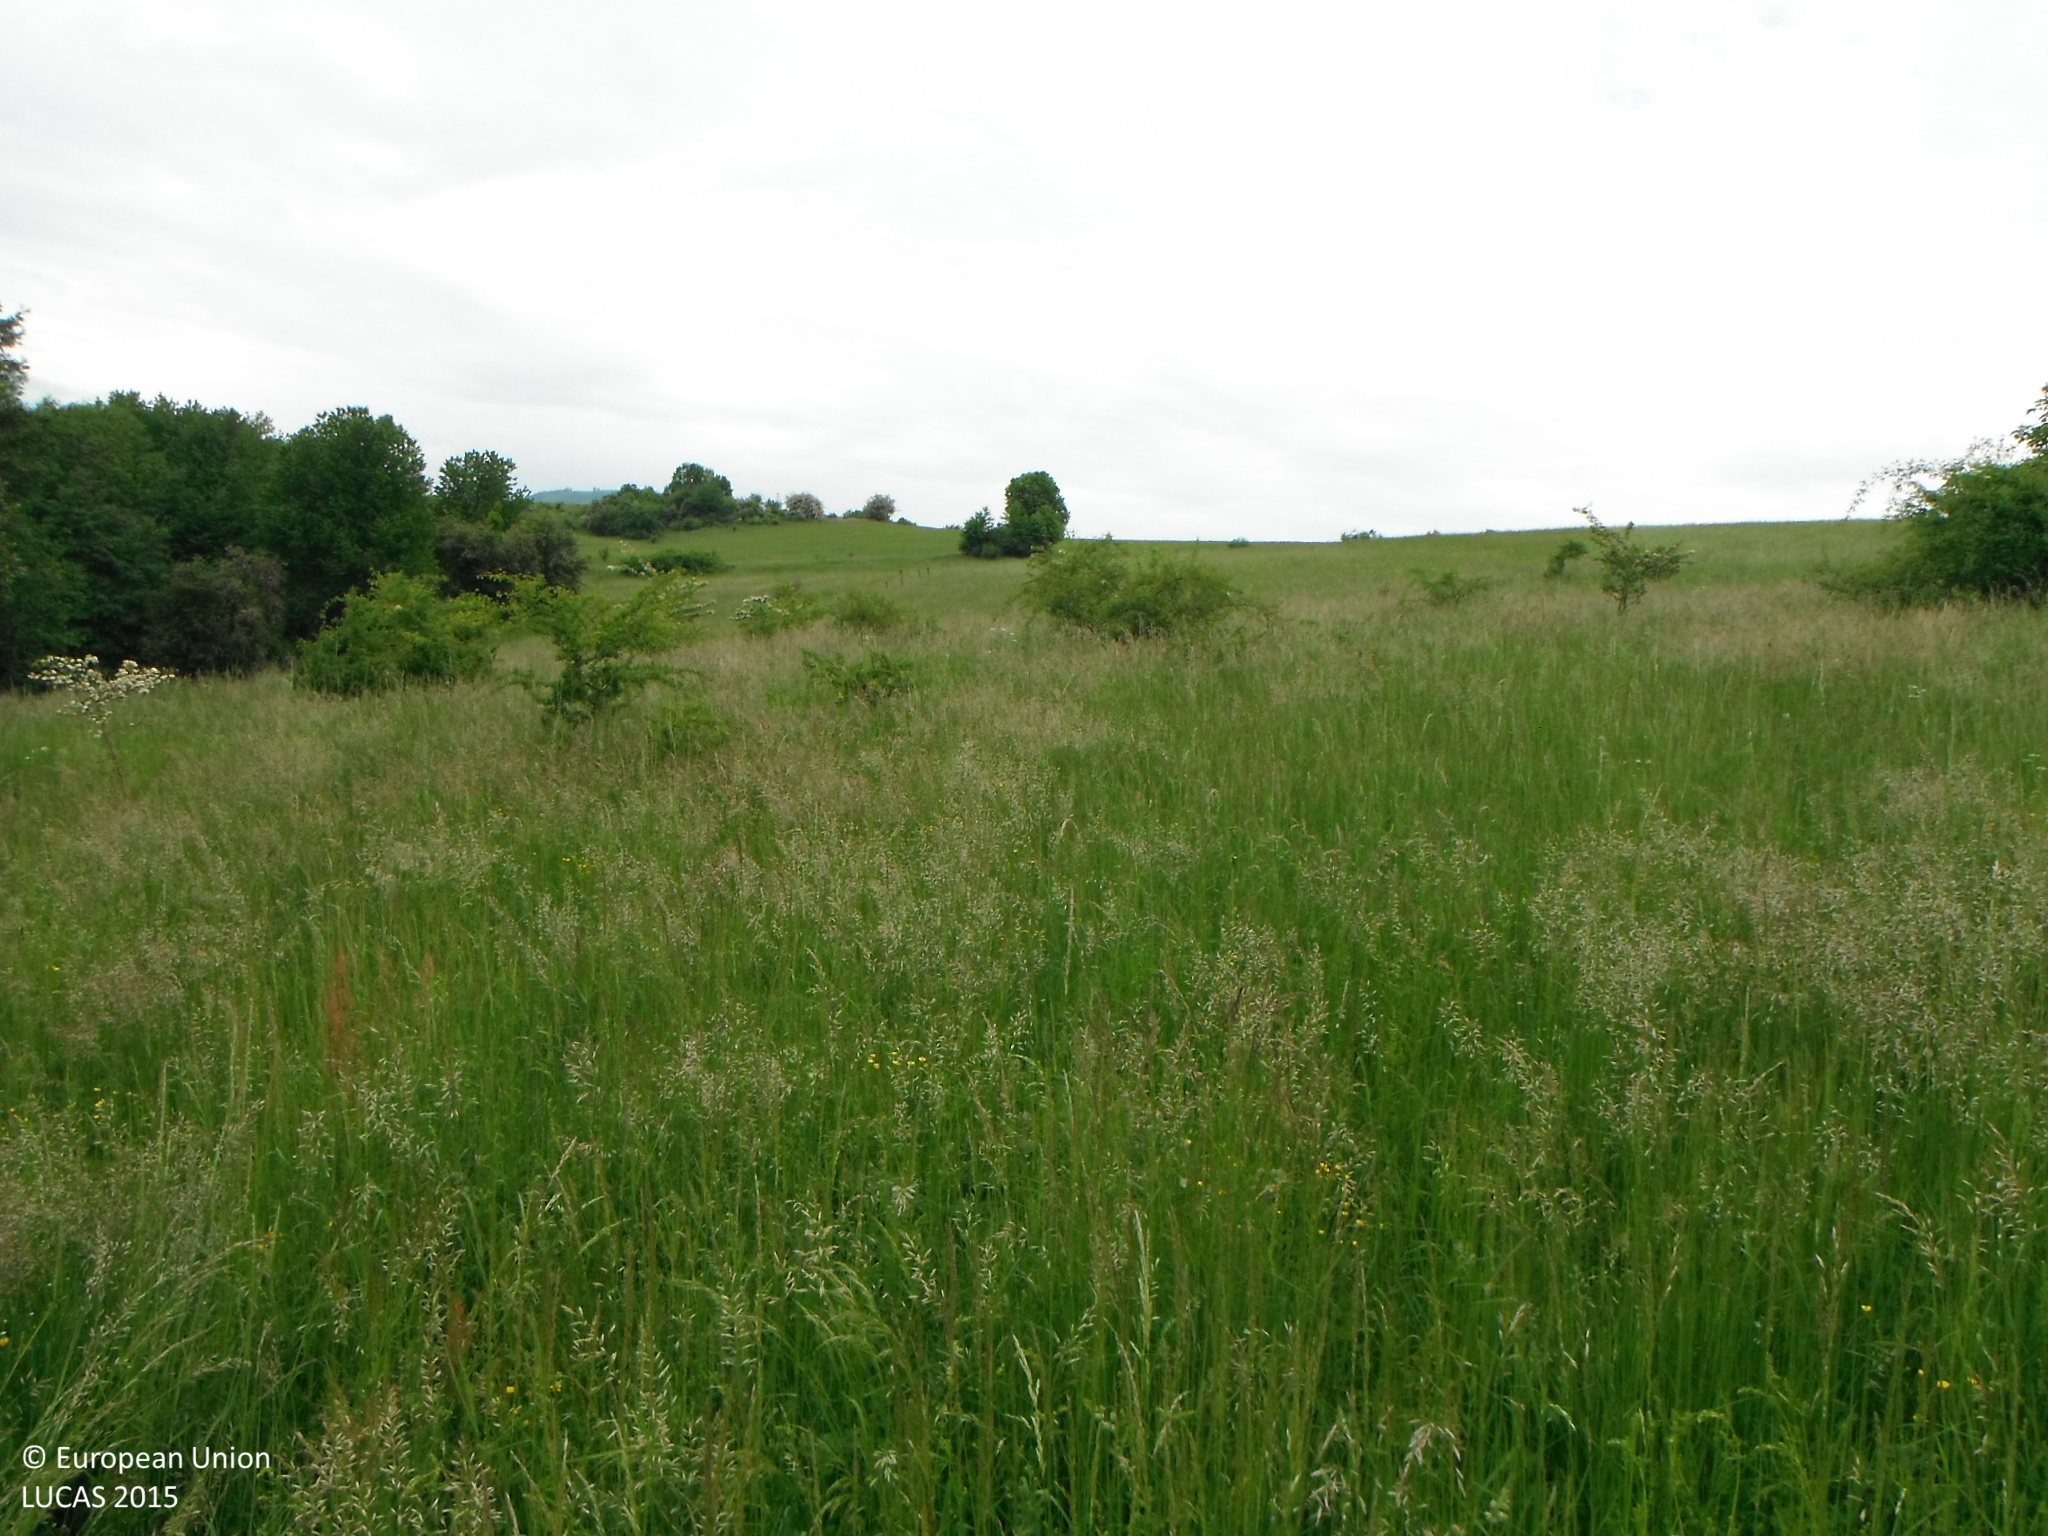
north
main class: Grassland
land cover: Grassland with sparse tree/shrub cover
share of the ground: > 75 %
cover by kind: herbaceous plants 85 %, shrubs 10 %, broadleaved forest trees 5 %
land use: Agriculture (excluding fallow land and kitchen gardens)
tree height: < 5 m
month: May
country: SK
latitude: 48.7456
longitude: 19.1751
